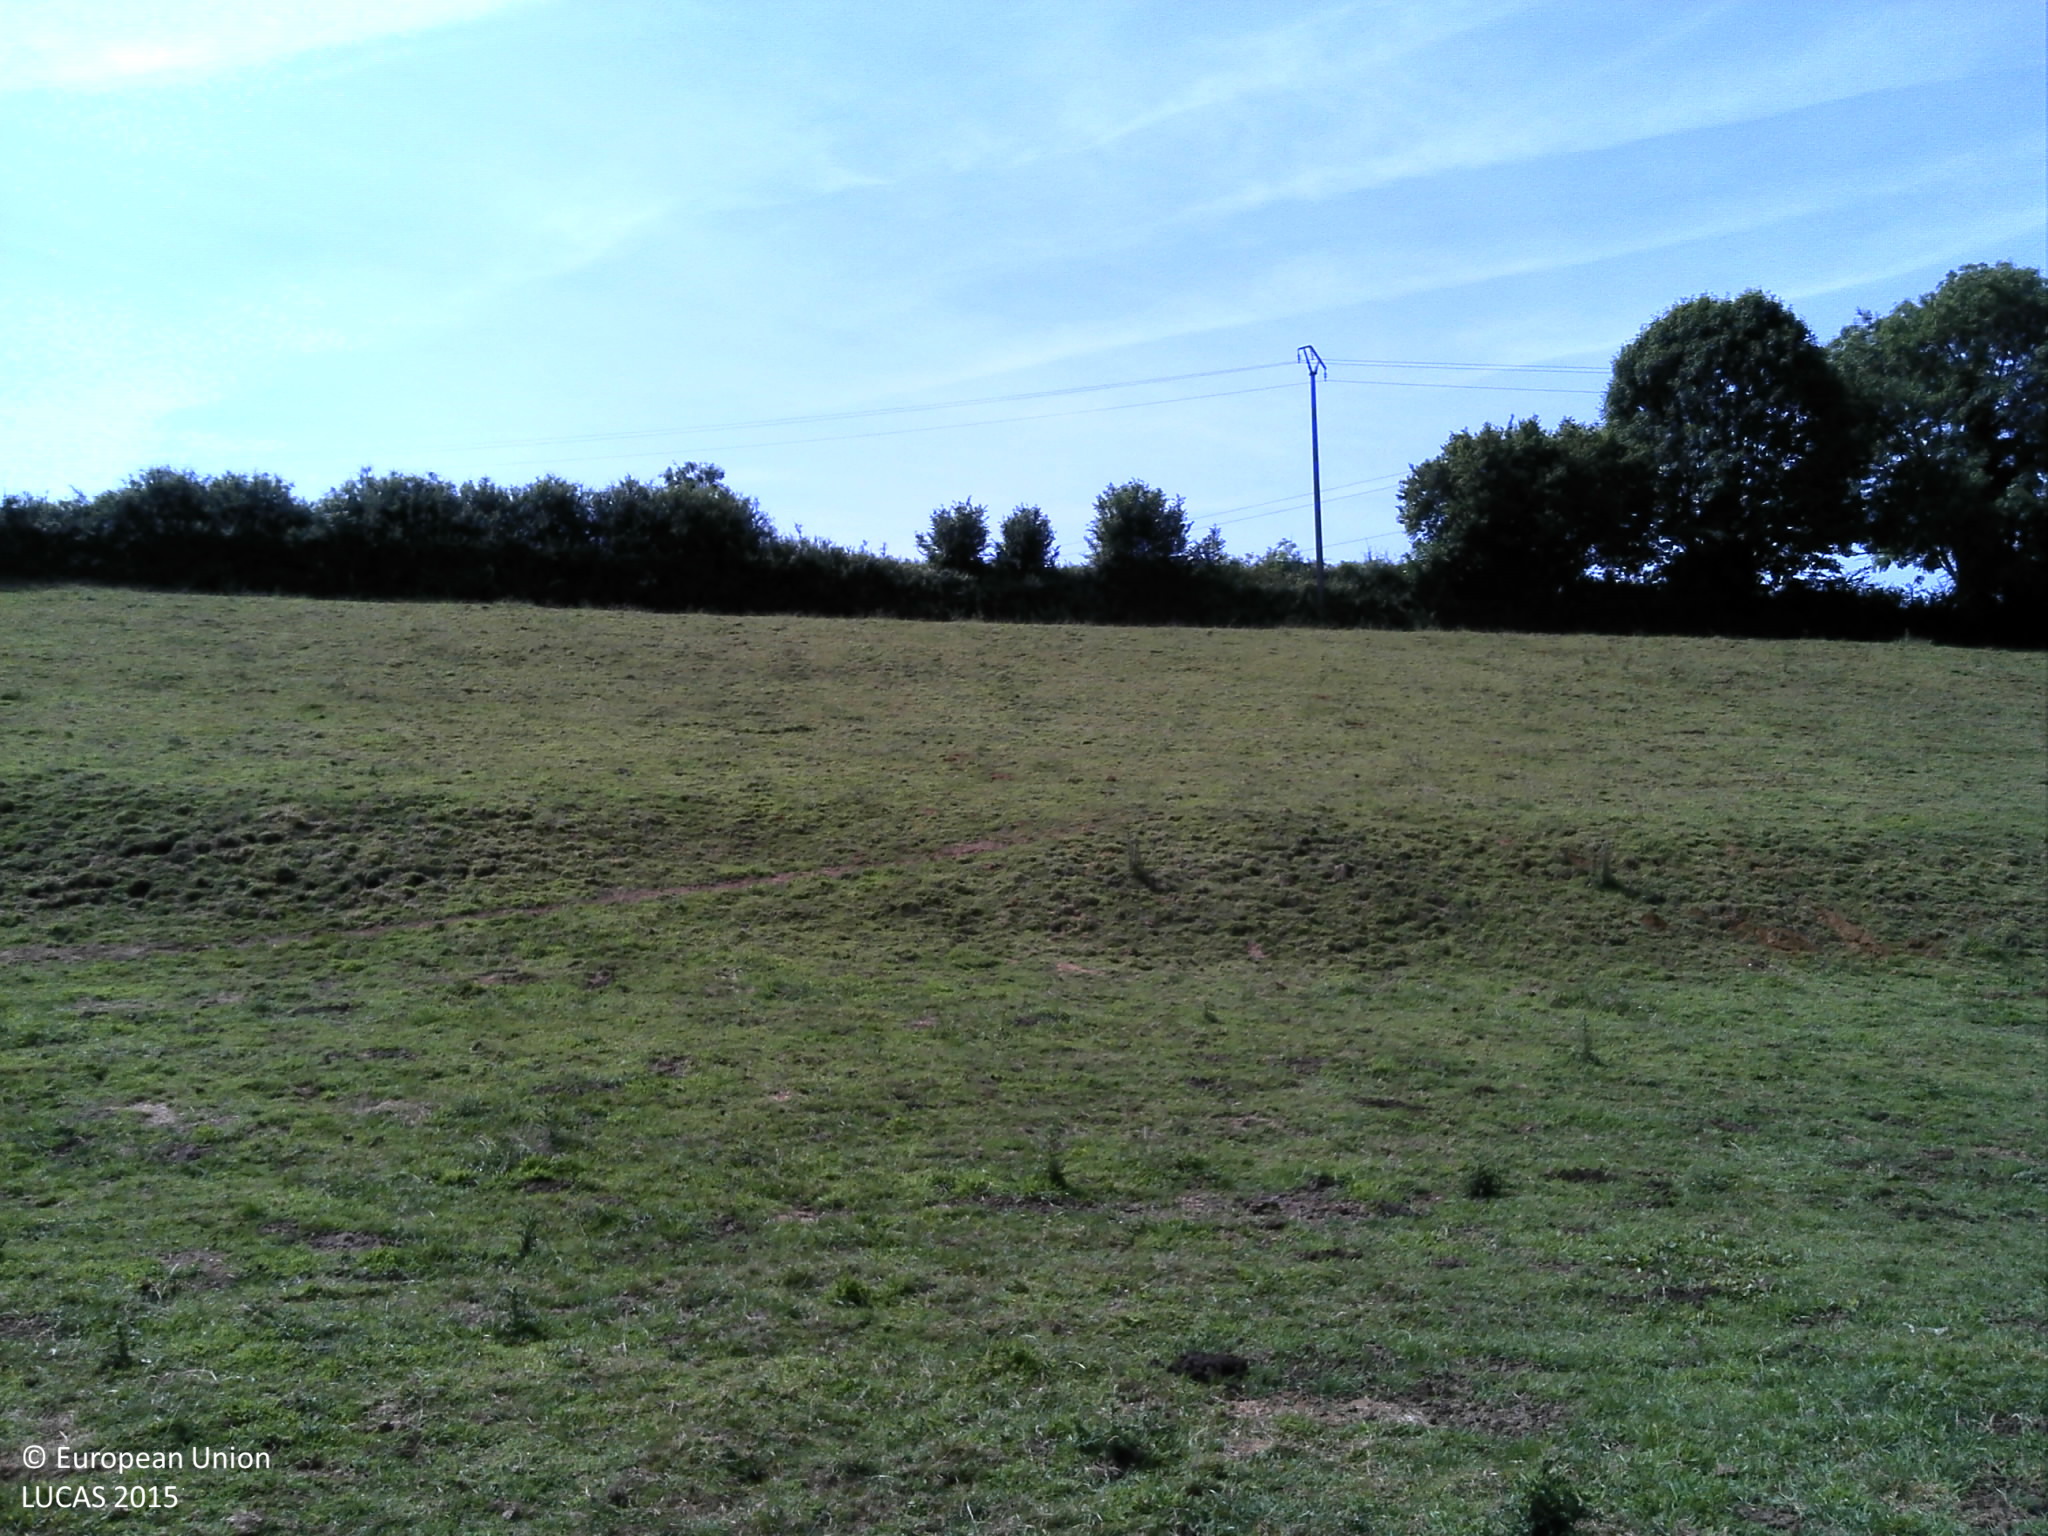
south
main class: Grassland
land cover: Grassland without tree/shrub cover
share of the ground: > 75 %
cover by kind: herbaceous plants 100 %
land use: Agriculture (excluding fallow land and kitchen gardens)
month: June
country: FR
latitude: 49.6959
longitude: 4.9927
